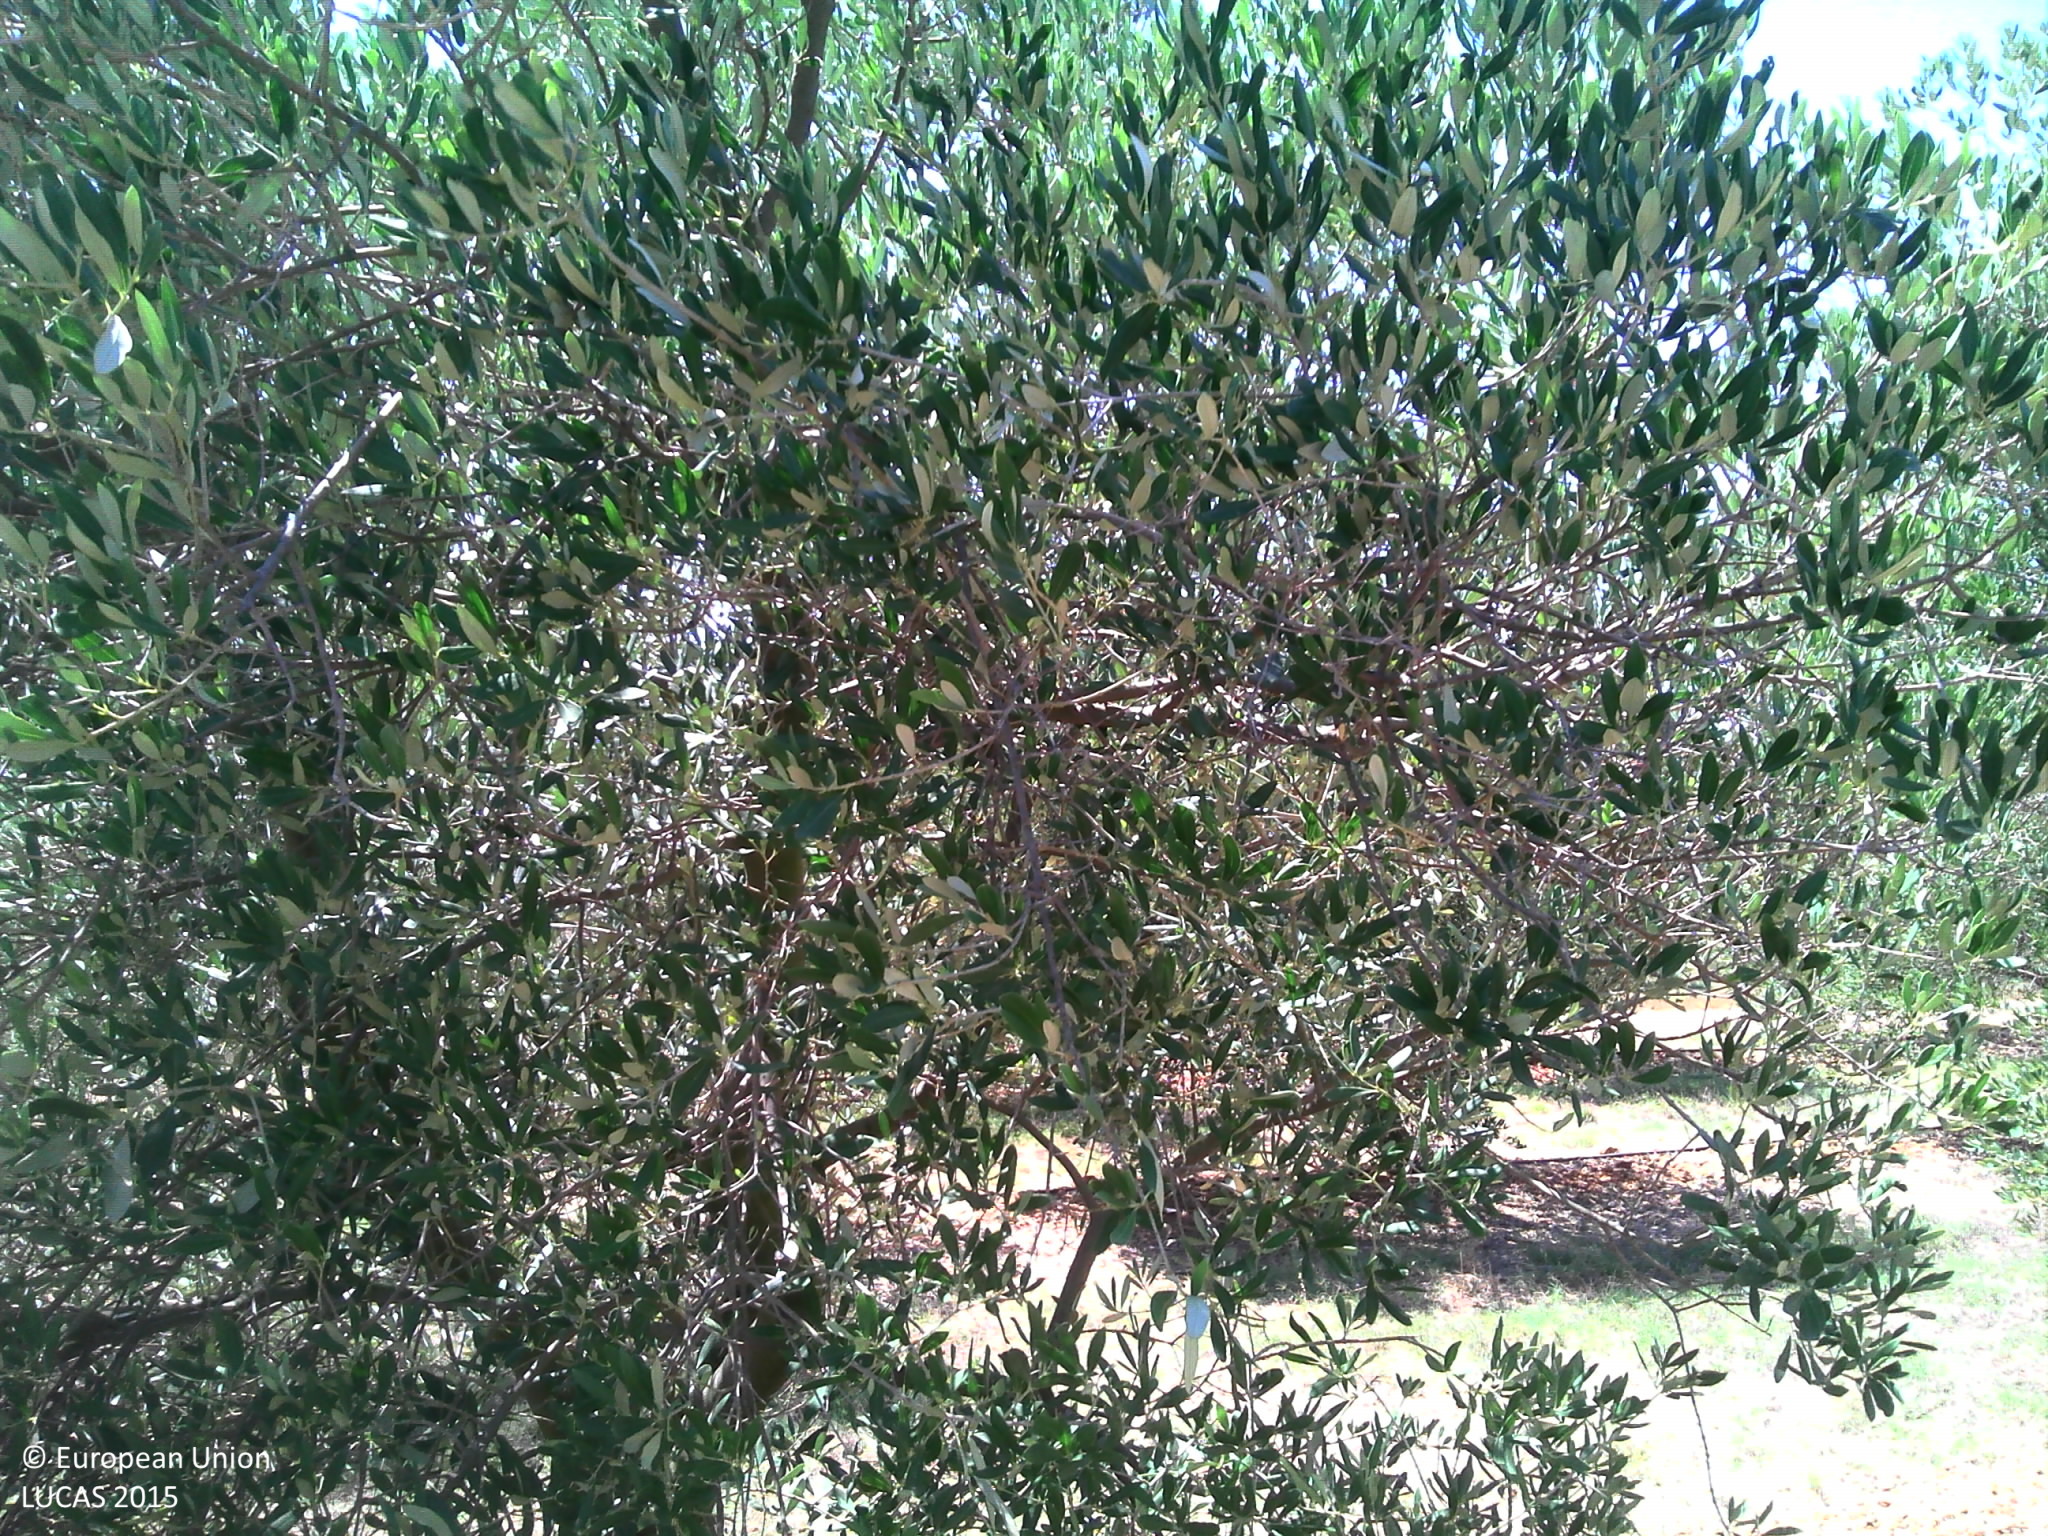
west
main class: Cropland
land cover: Olive groves
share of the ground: 25 - 50 %
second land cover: Grassland without tree/shrub cover
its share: > 75 %
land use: Agriculture (excluding fallow land and kitchen gardens)
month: July
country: FR
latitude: 43.6761
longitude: 4.7627
